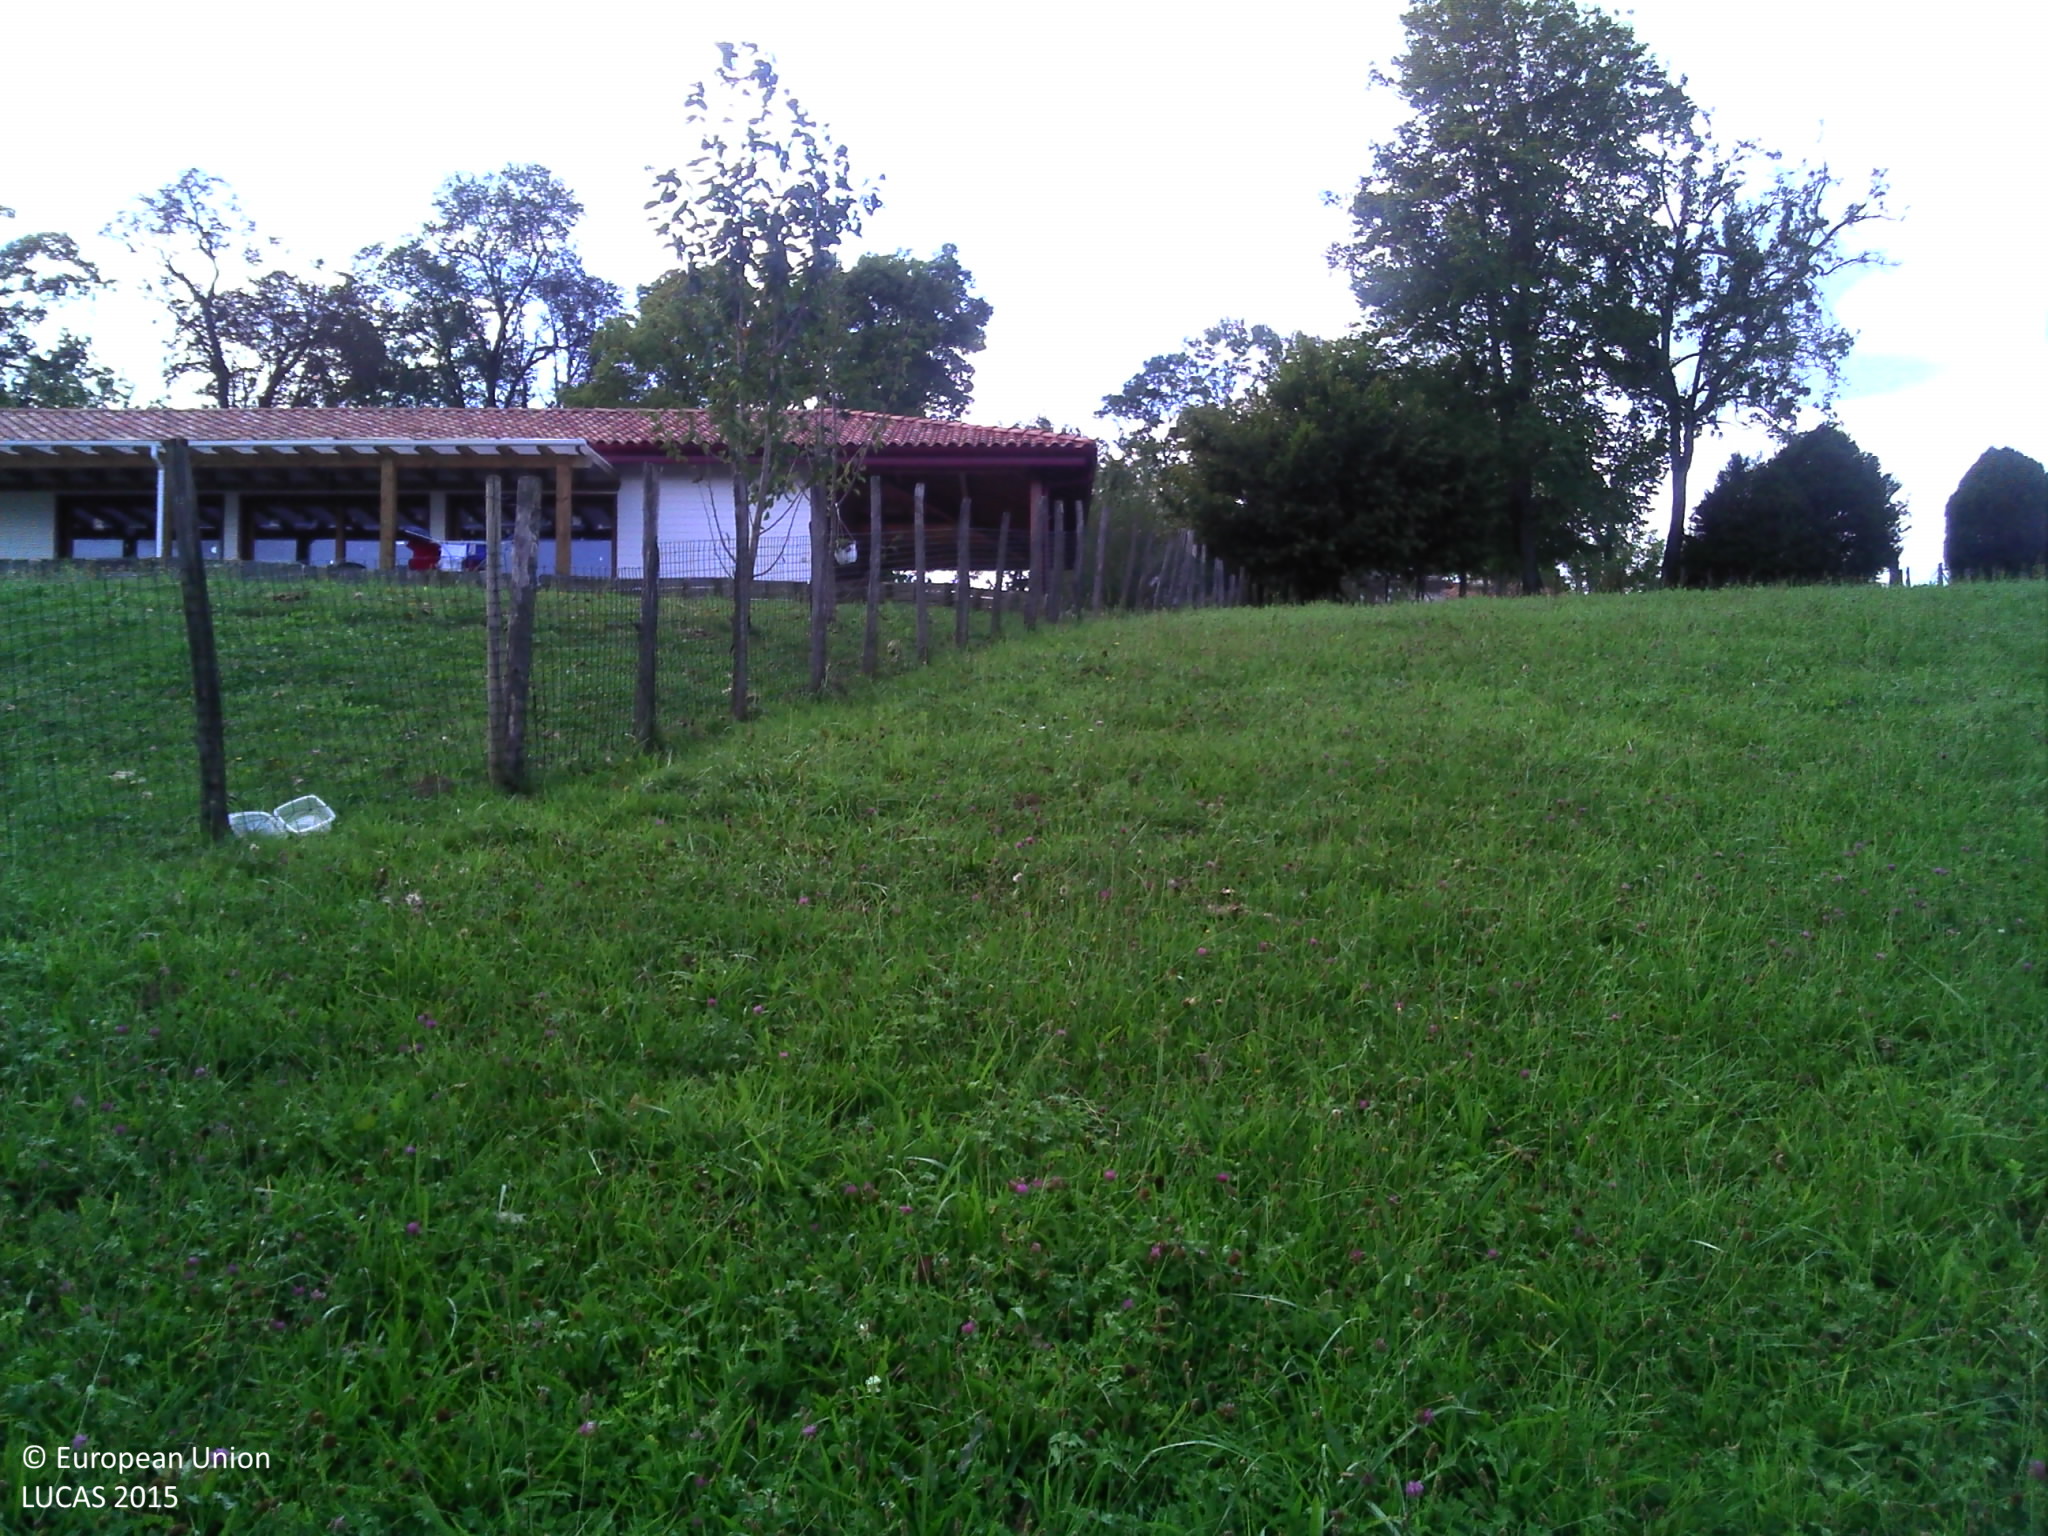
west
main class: Grassland
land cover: Grassland without tree/shrub cover
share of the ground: > 75 %
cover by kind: herbaceous plants 100 %
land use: Agriculture (excluding fallow land and kitchen gardens)
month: September
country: FR
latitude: 43.1375
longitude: -1.2378
